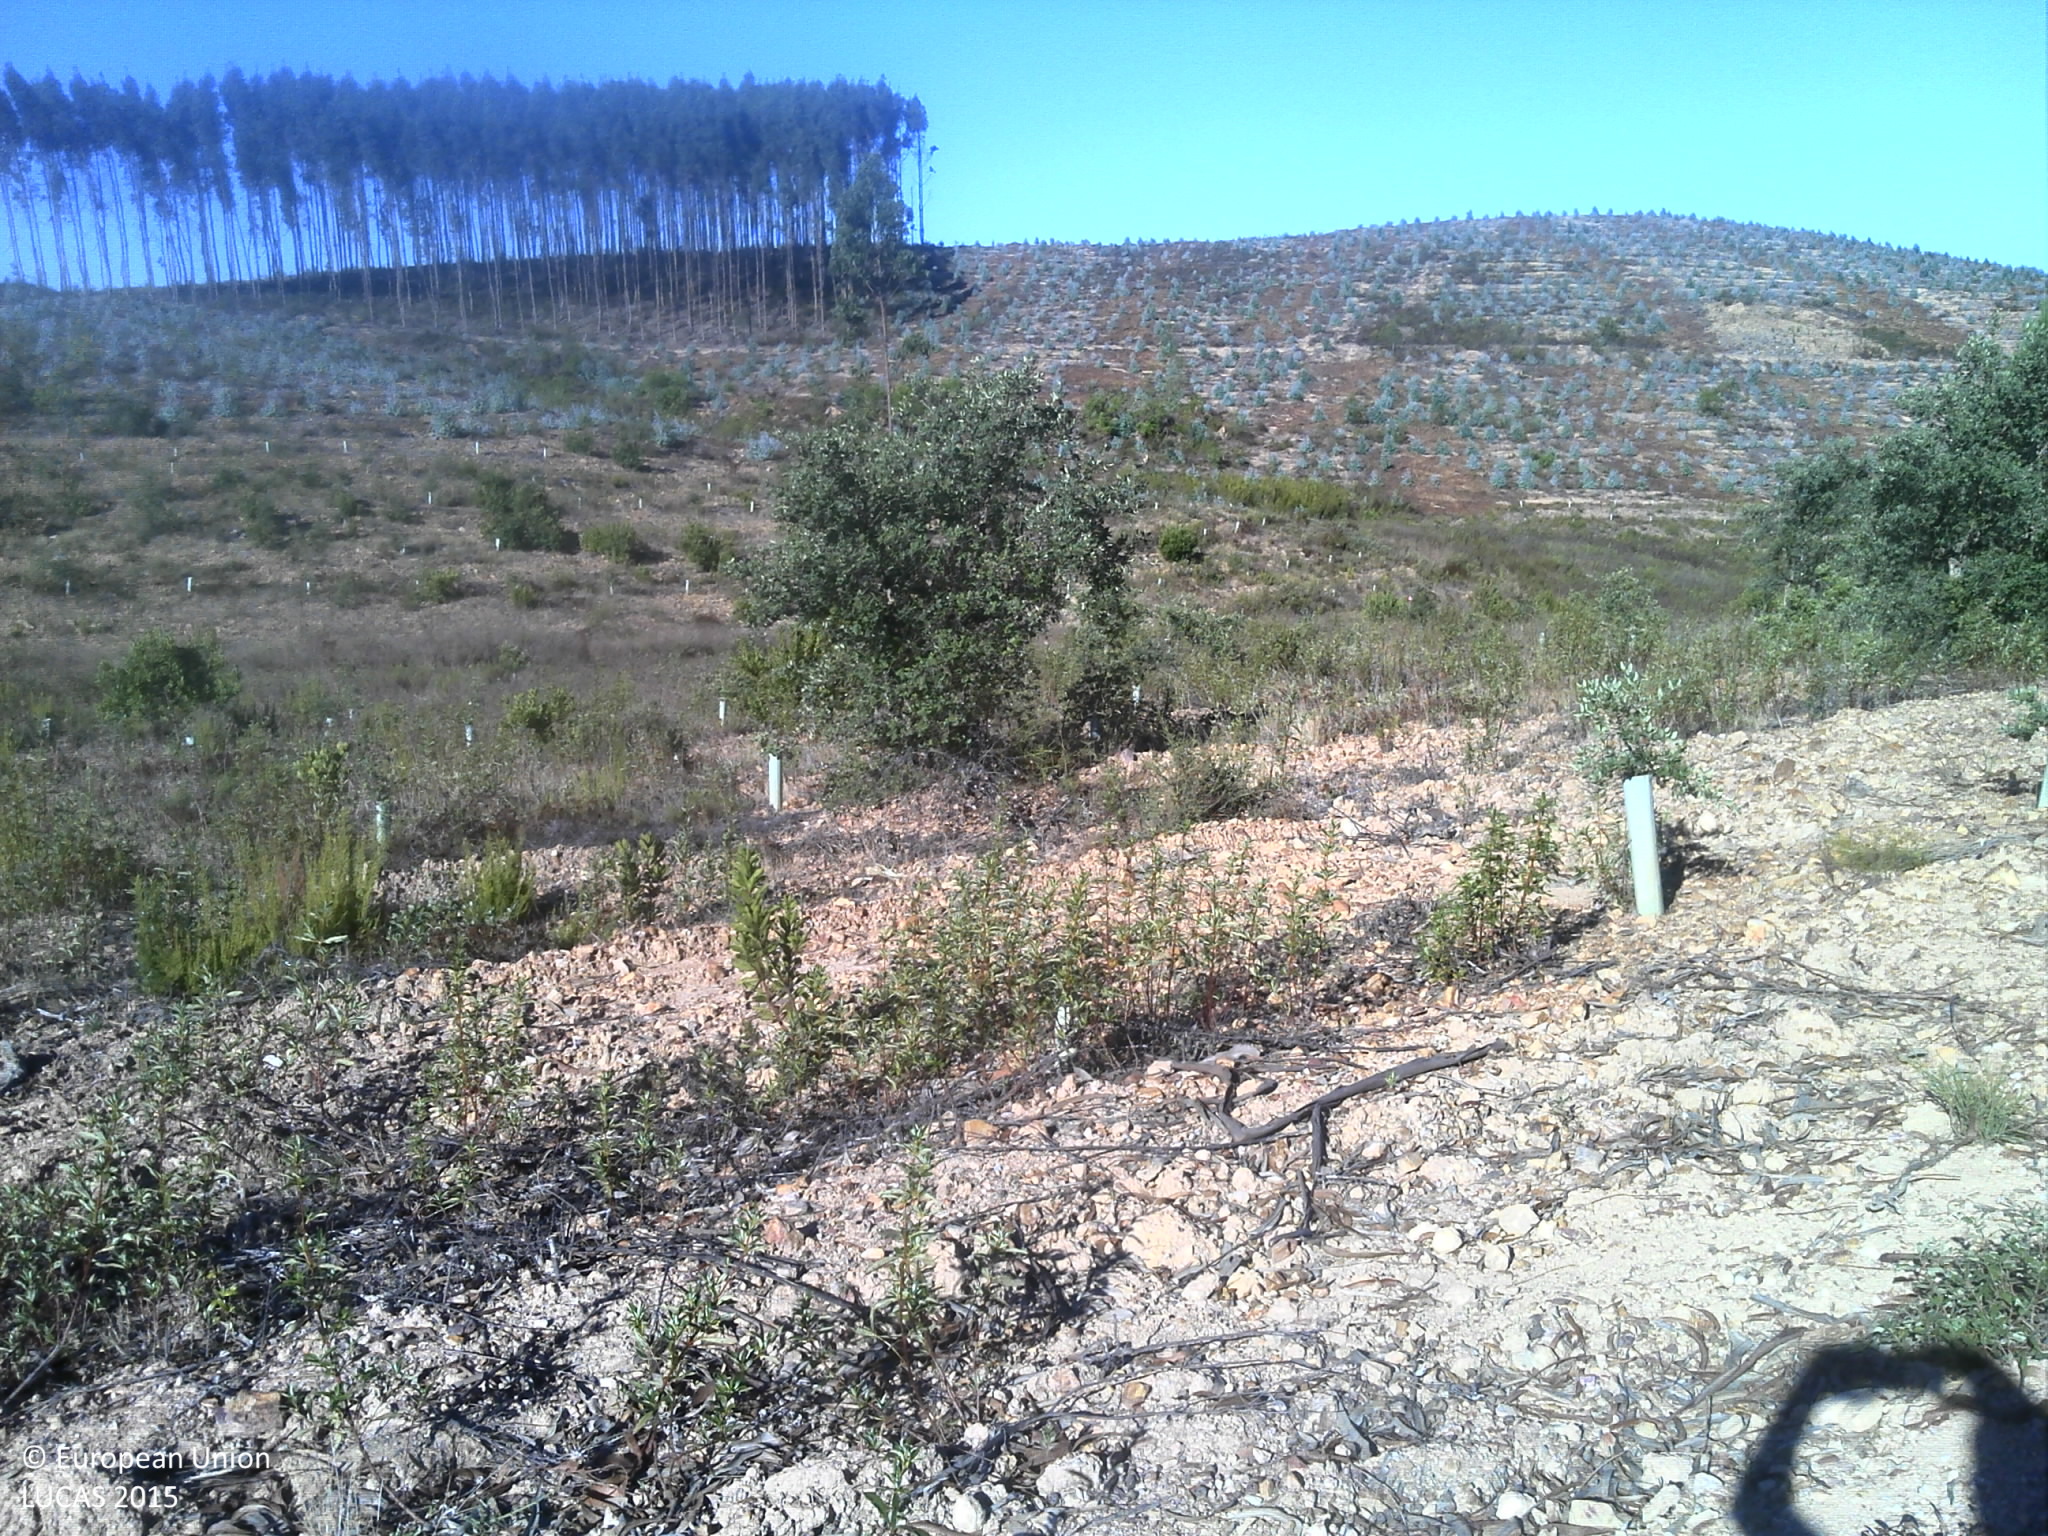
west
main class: Woodland
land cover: Broadleaved woodland
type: exotic forest
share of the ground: < 10 %
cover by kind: unconsolidated bare surface 80 %, broadleaved forest trees 10 %, herbaceous plants 10 %
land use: Forestry
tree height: < 5 m
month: August
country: PT
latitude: 37.2708
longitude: -8.7655
